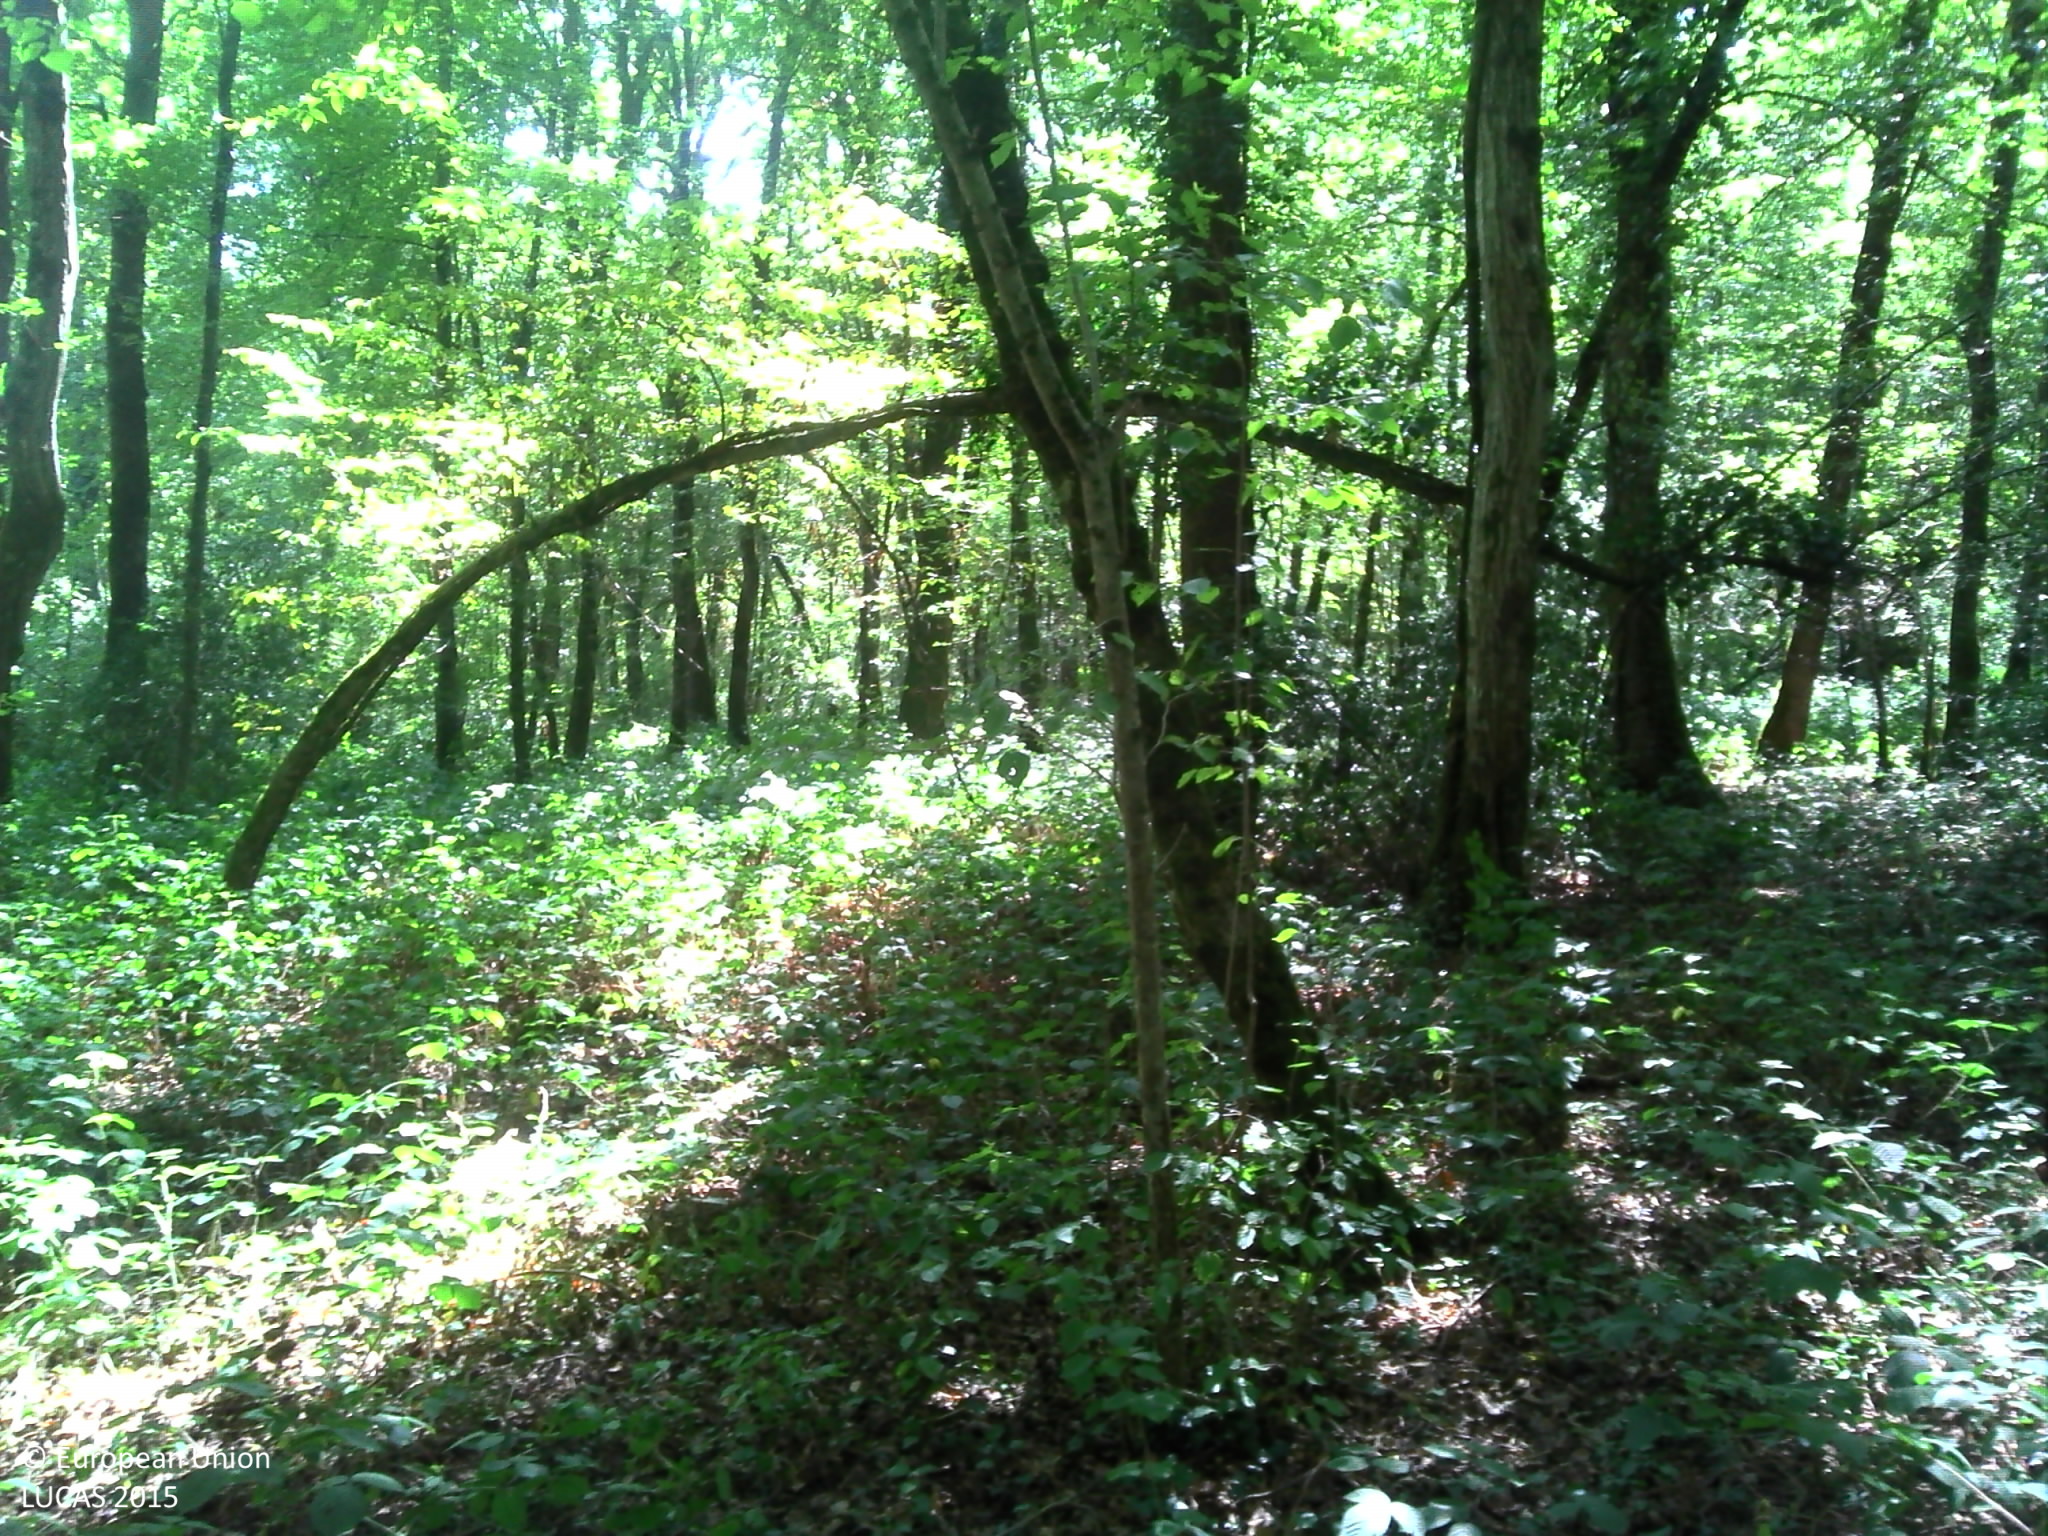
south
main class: Woodland
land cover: Broadleaved woodland
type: mesophytic deciduous forest
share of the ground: > 75 %
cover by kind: broadleaved forest trees 100 %
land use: Forestry
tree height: > 5 m
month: September
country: FR
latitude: 47.4049
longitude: 6.3045
